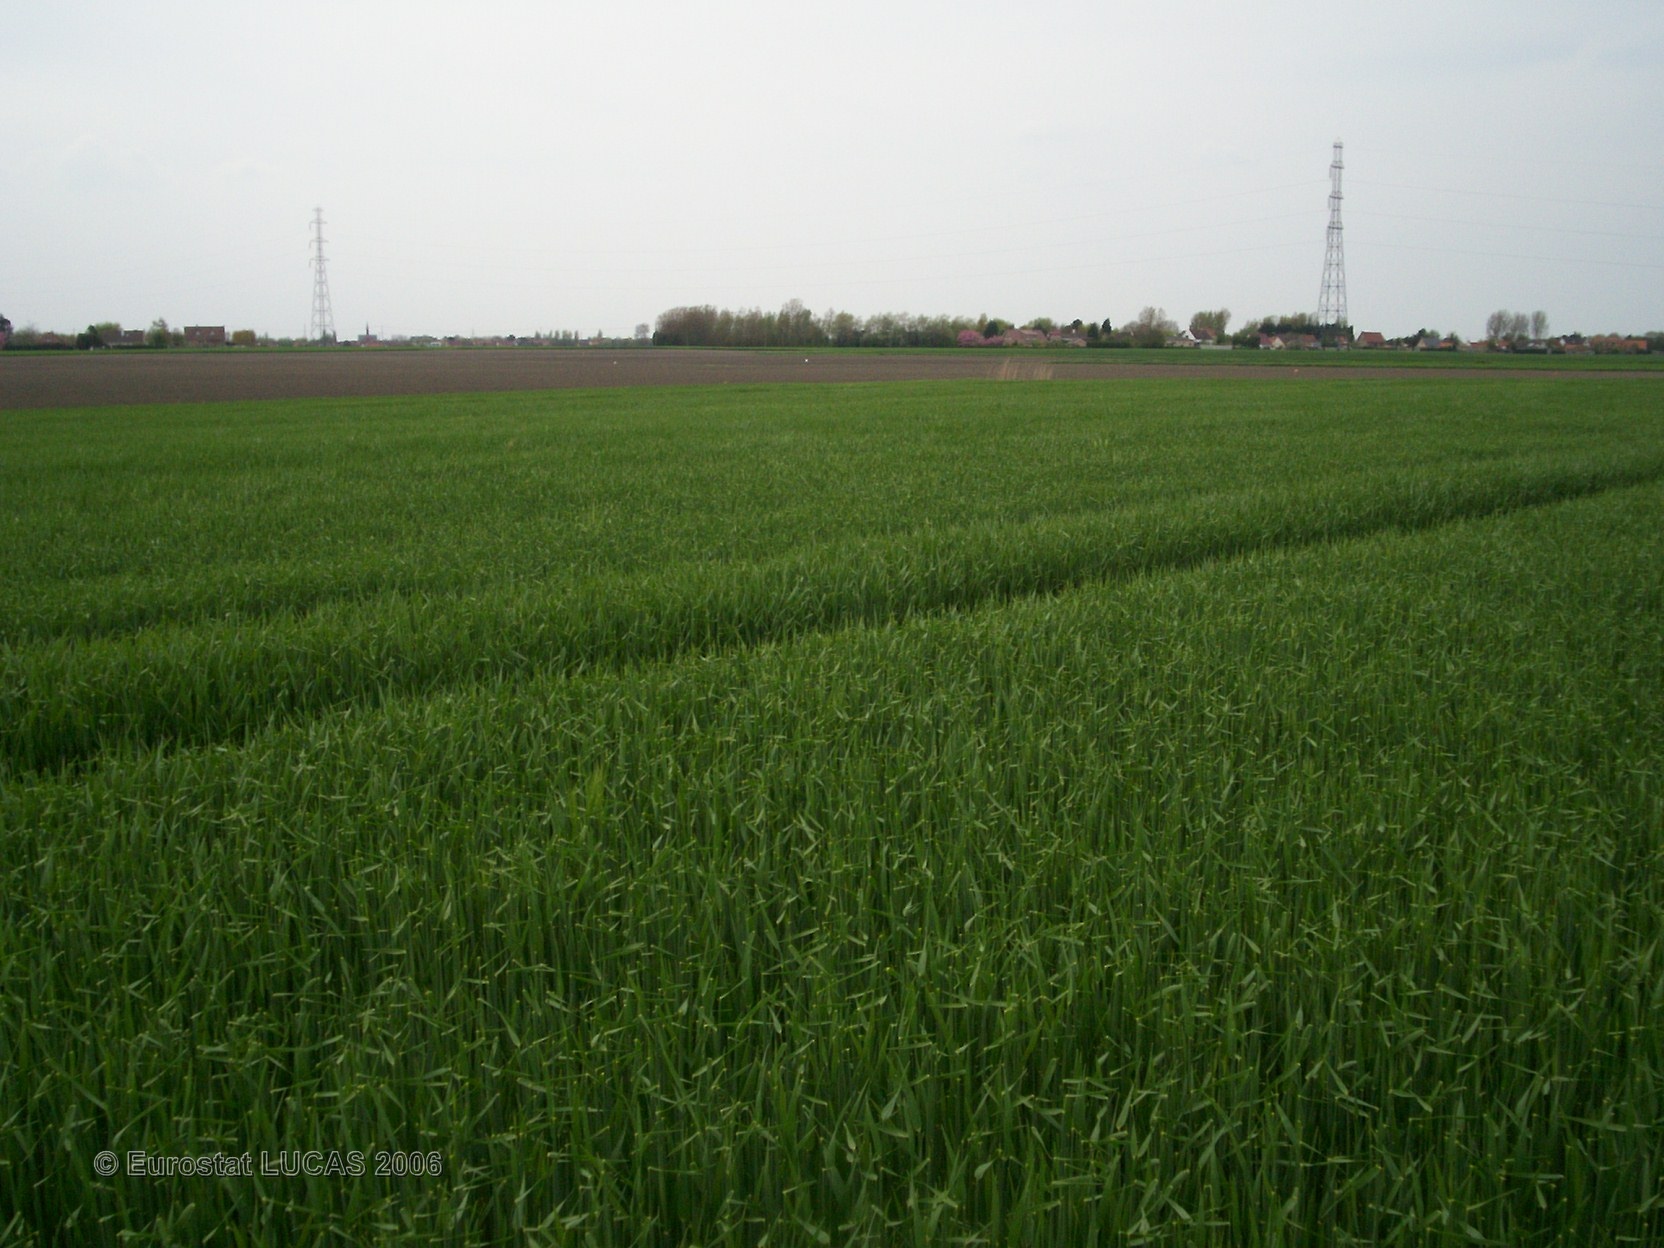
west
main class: Cropland
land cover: Barley
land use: Agriculture (excluding fallow land and kitchen gardens)
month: May
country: FR
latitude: 51.0189
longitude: 2.4744
